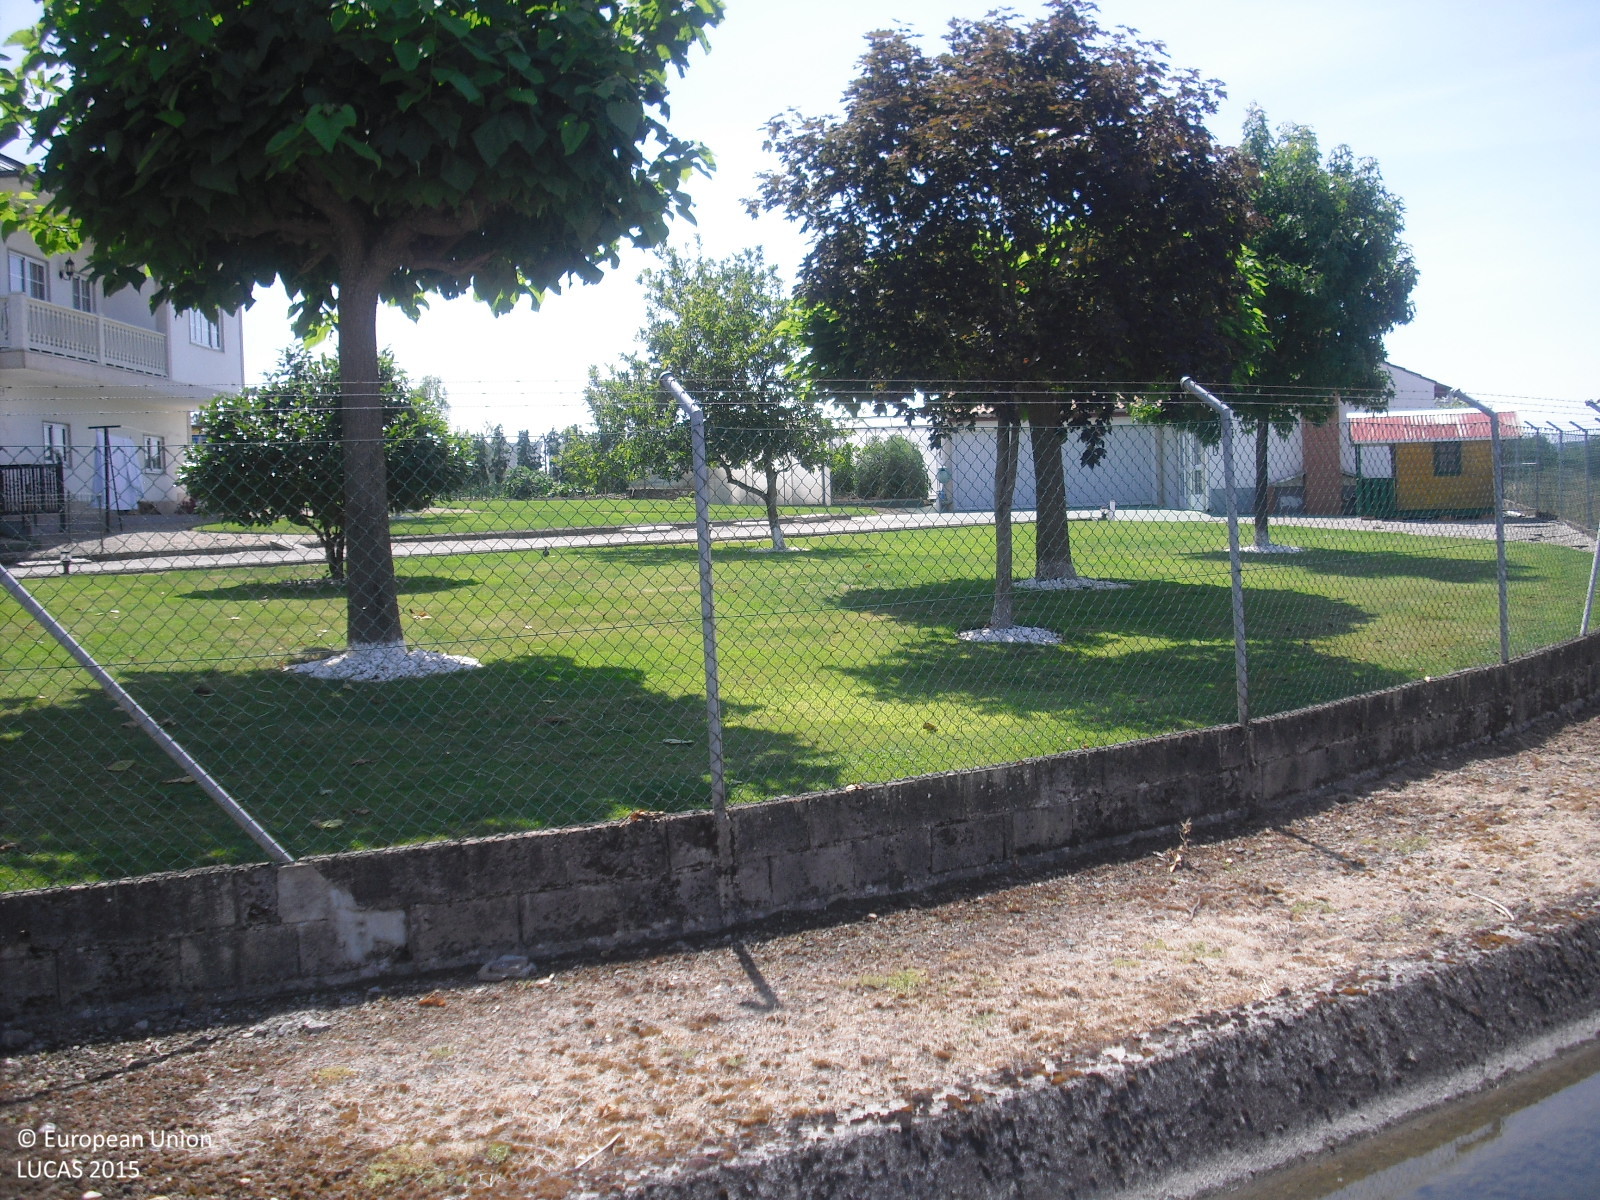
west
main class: Grassland
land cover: Grassland with sparse tree/shrub cover
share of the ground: > 75 %
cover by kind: herbaceous plants 90 %, broadleaved forest trees 5 %, shrubs 5 %
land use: Residential
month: July
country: ES
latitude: 42.5196
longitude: -7.4877
